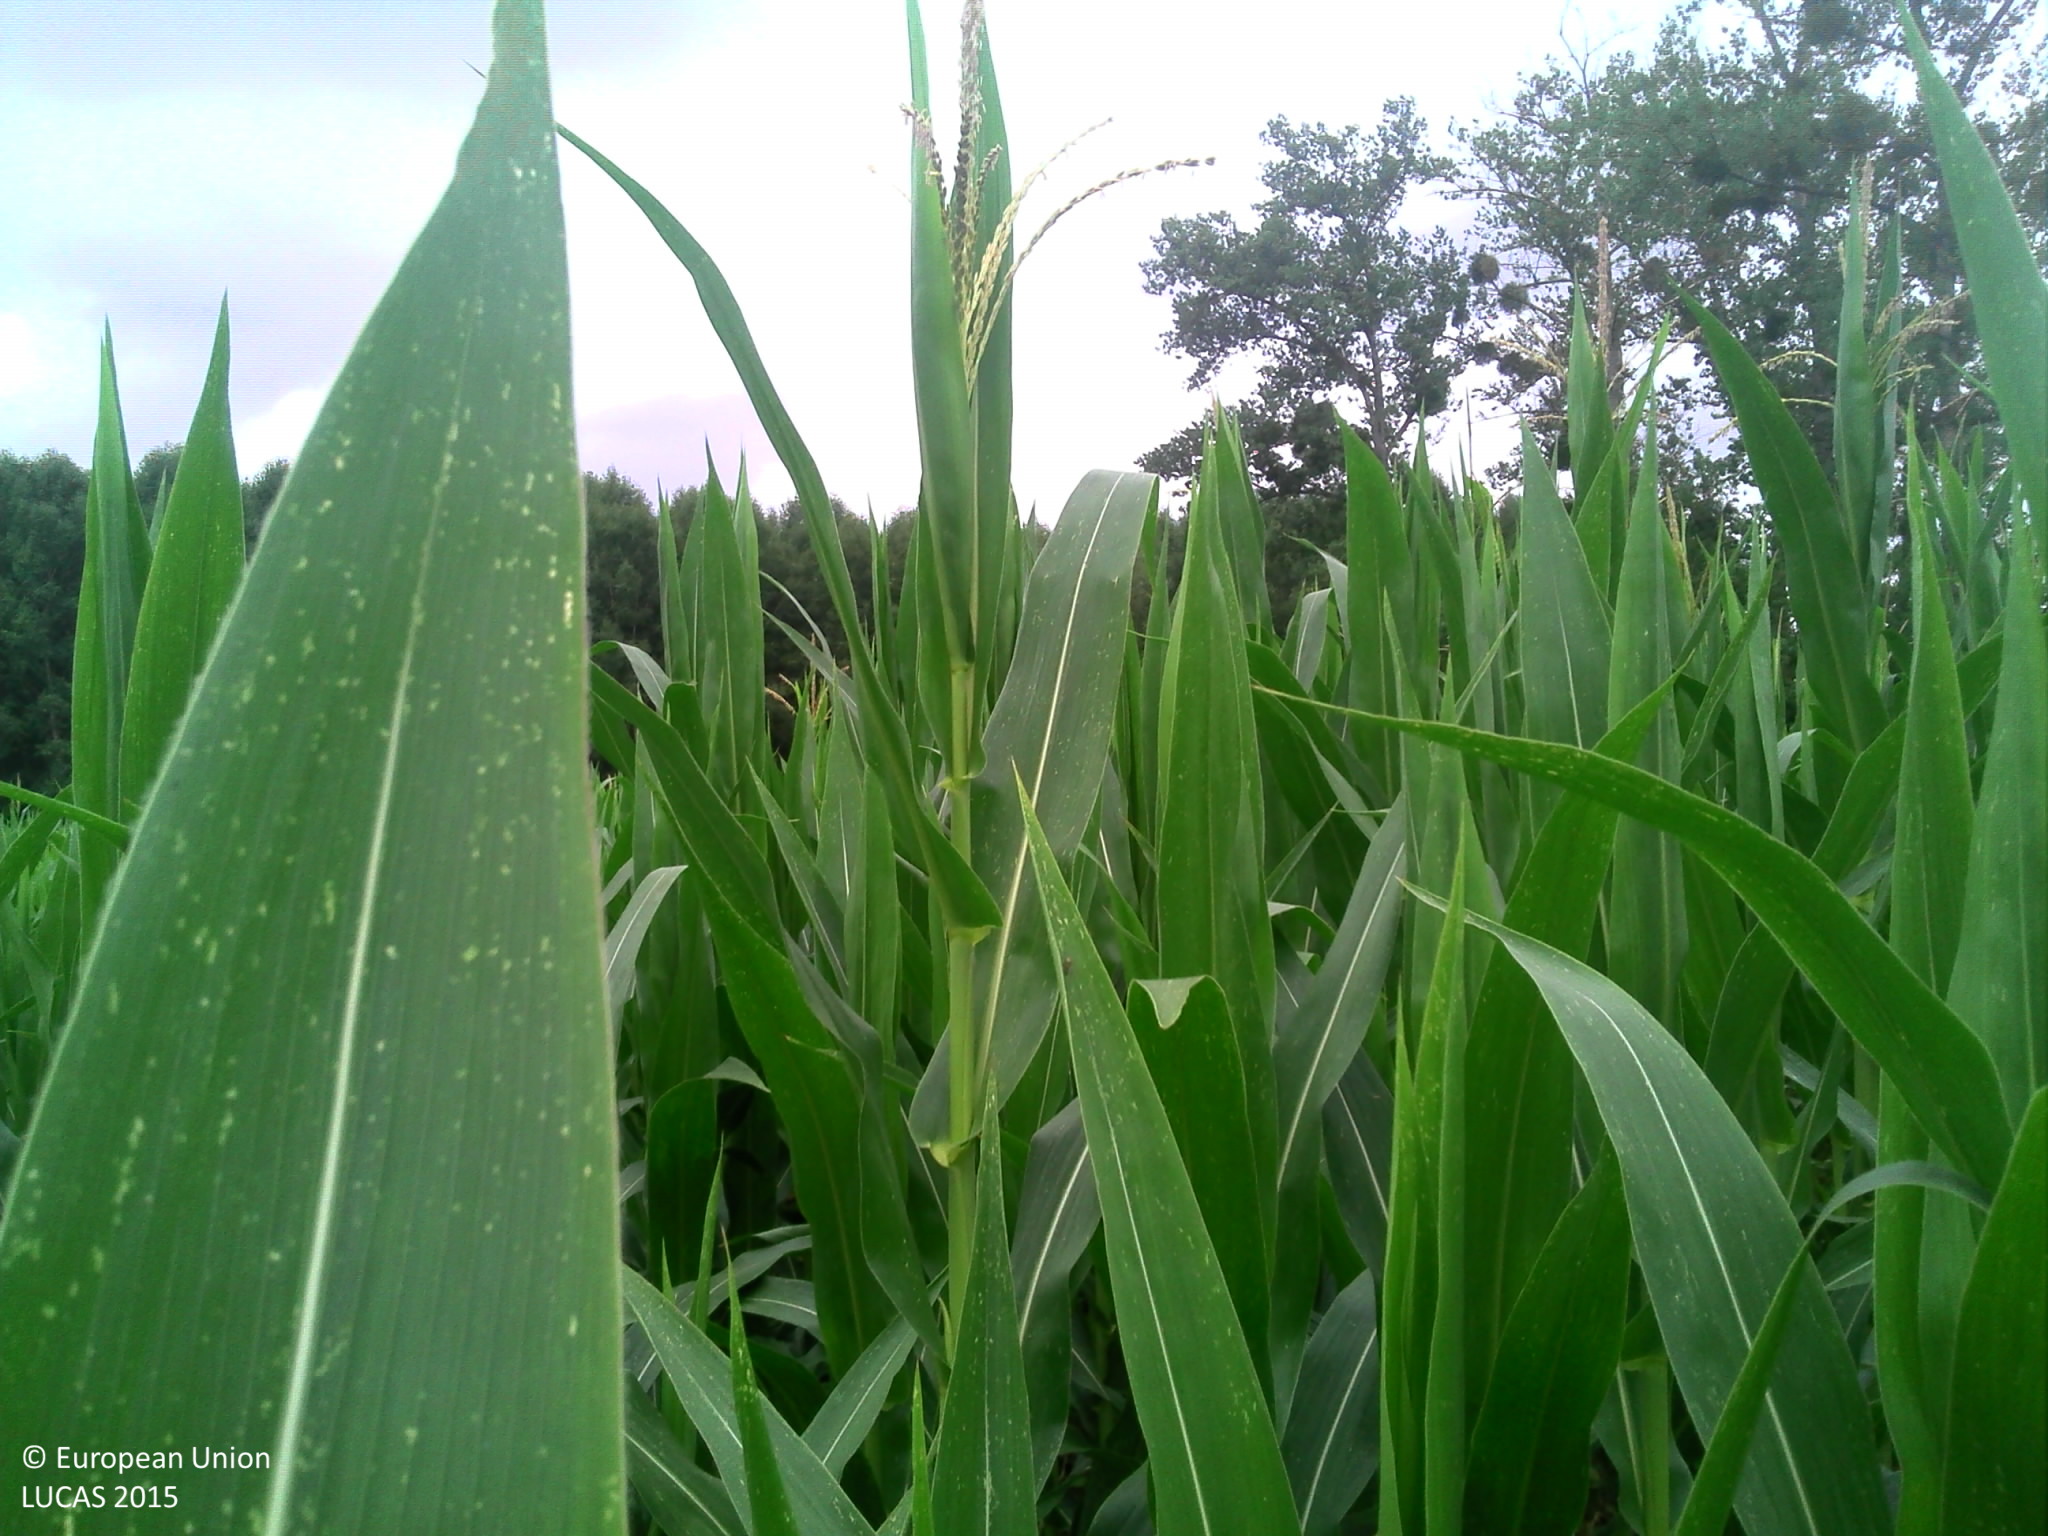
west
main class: Cropland
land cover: Maize
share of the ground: > 75 %
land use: Agriculture (excluding fallow land and kitchen gardens)
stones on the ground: < 10 %
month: July
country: FR
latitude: 43.2559
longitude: 0.8494
